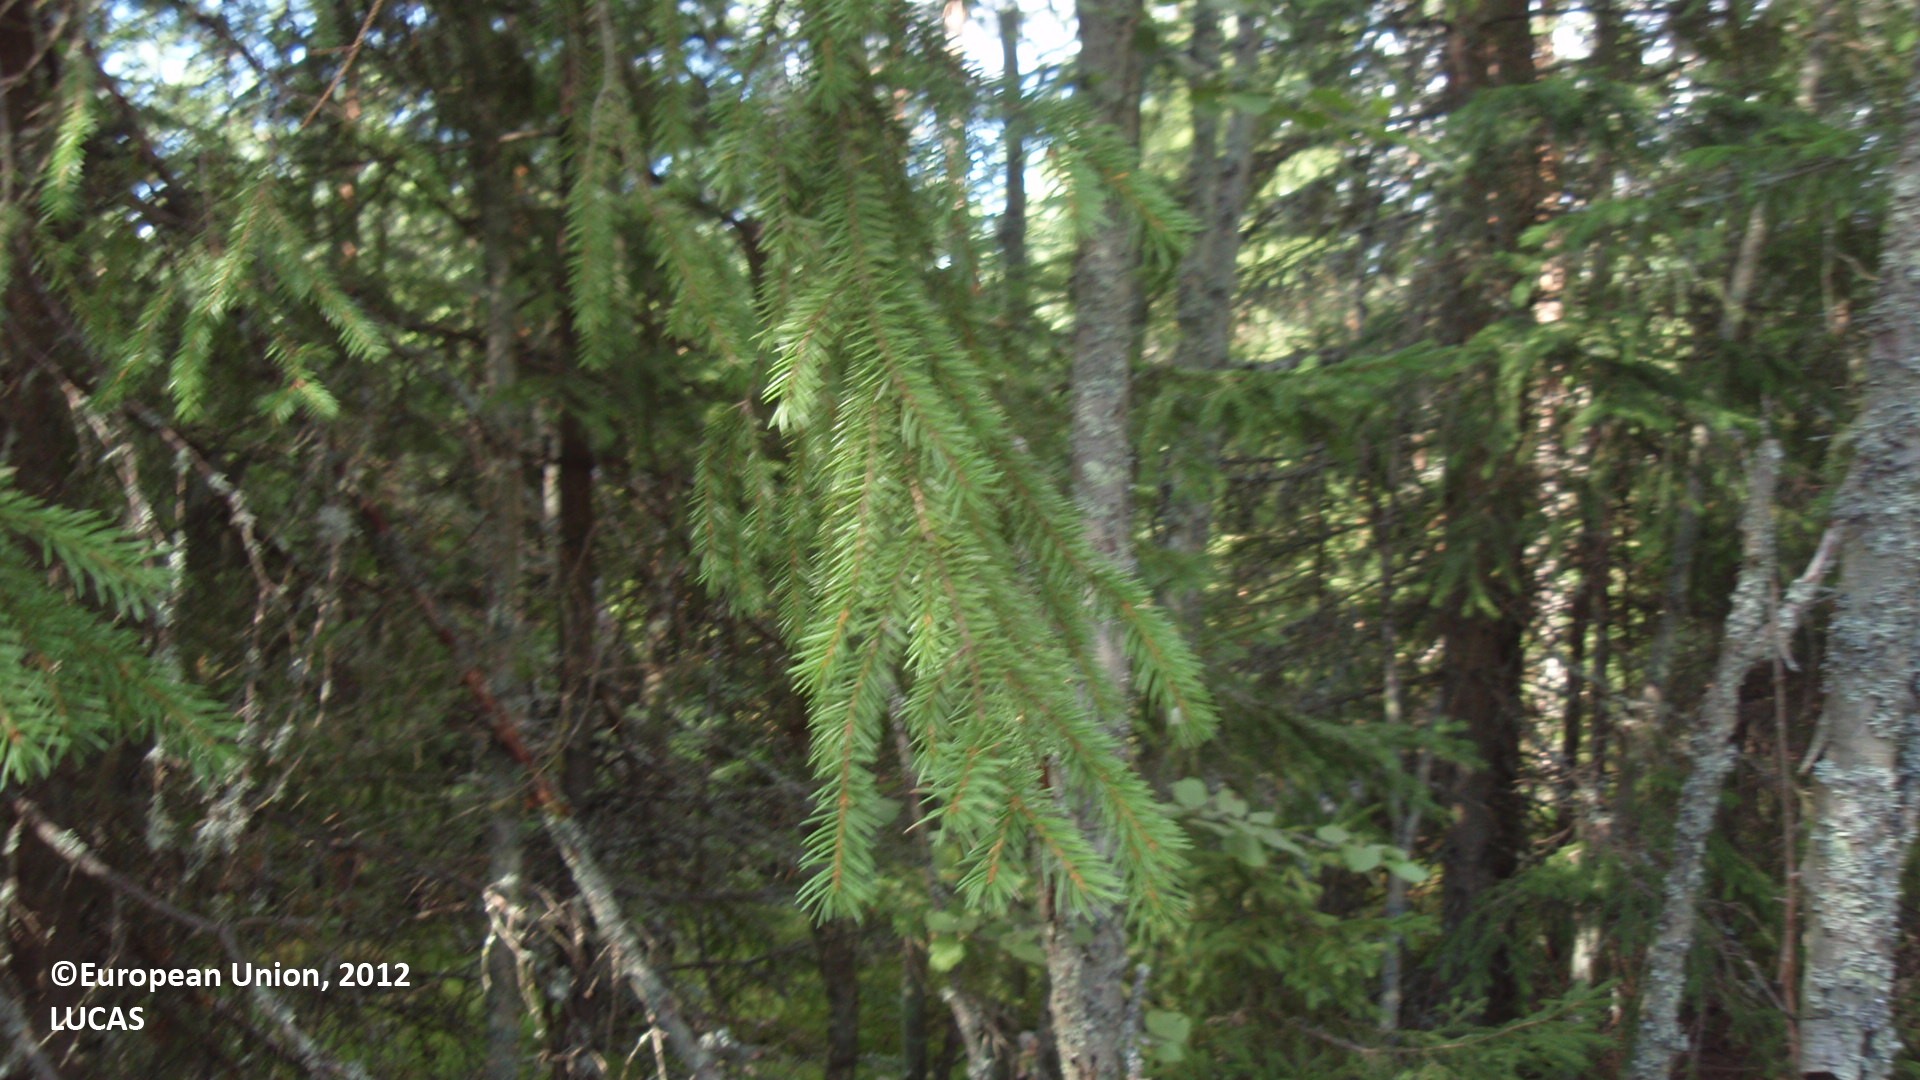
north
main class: Woodland
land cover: Pine dominated coniferous woodland
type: boreal forest
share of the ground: 50 - 75 %
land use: Forestry
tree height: > 5 m
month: August
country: FI
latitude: 61.1539
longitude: 27.7478
